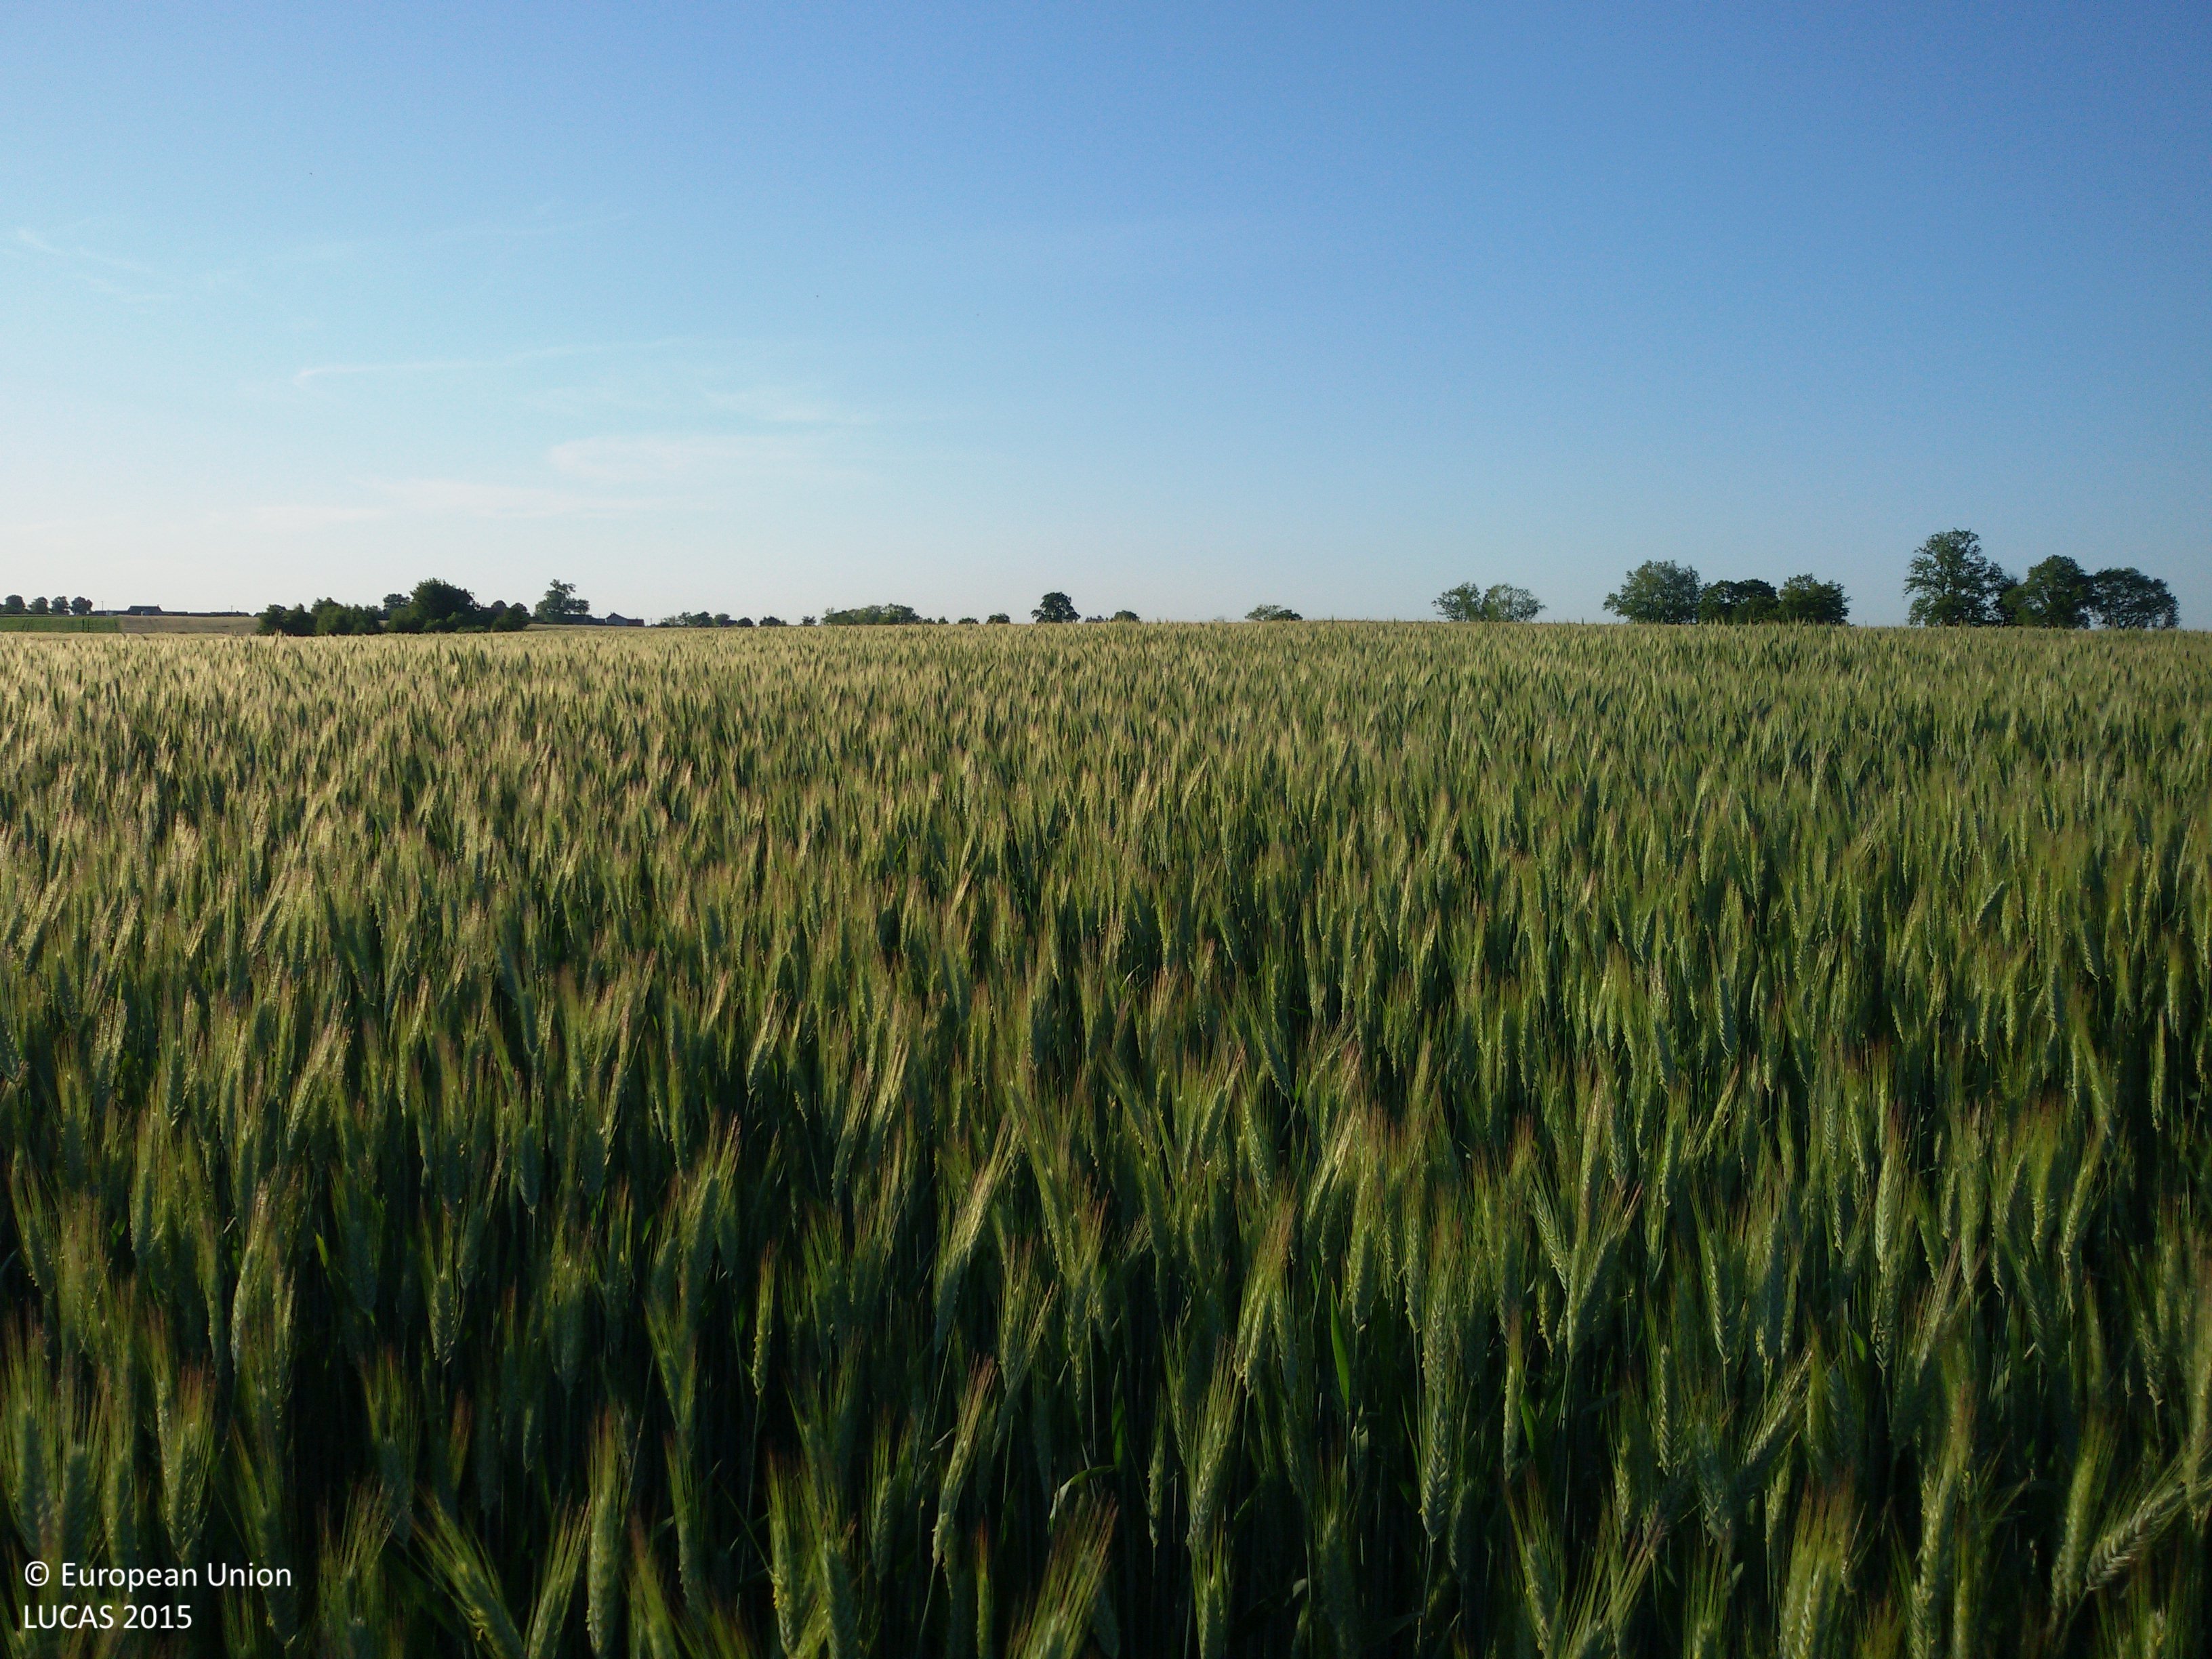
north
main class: Cropland
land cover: Triticale
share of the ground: > 75 %
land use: Agriculture (excluding fallow land and kitchen gardens)
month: June
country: PL
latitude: 53.2316
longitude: 17.0656
